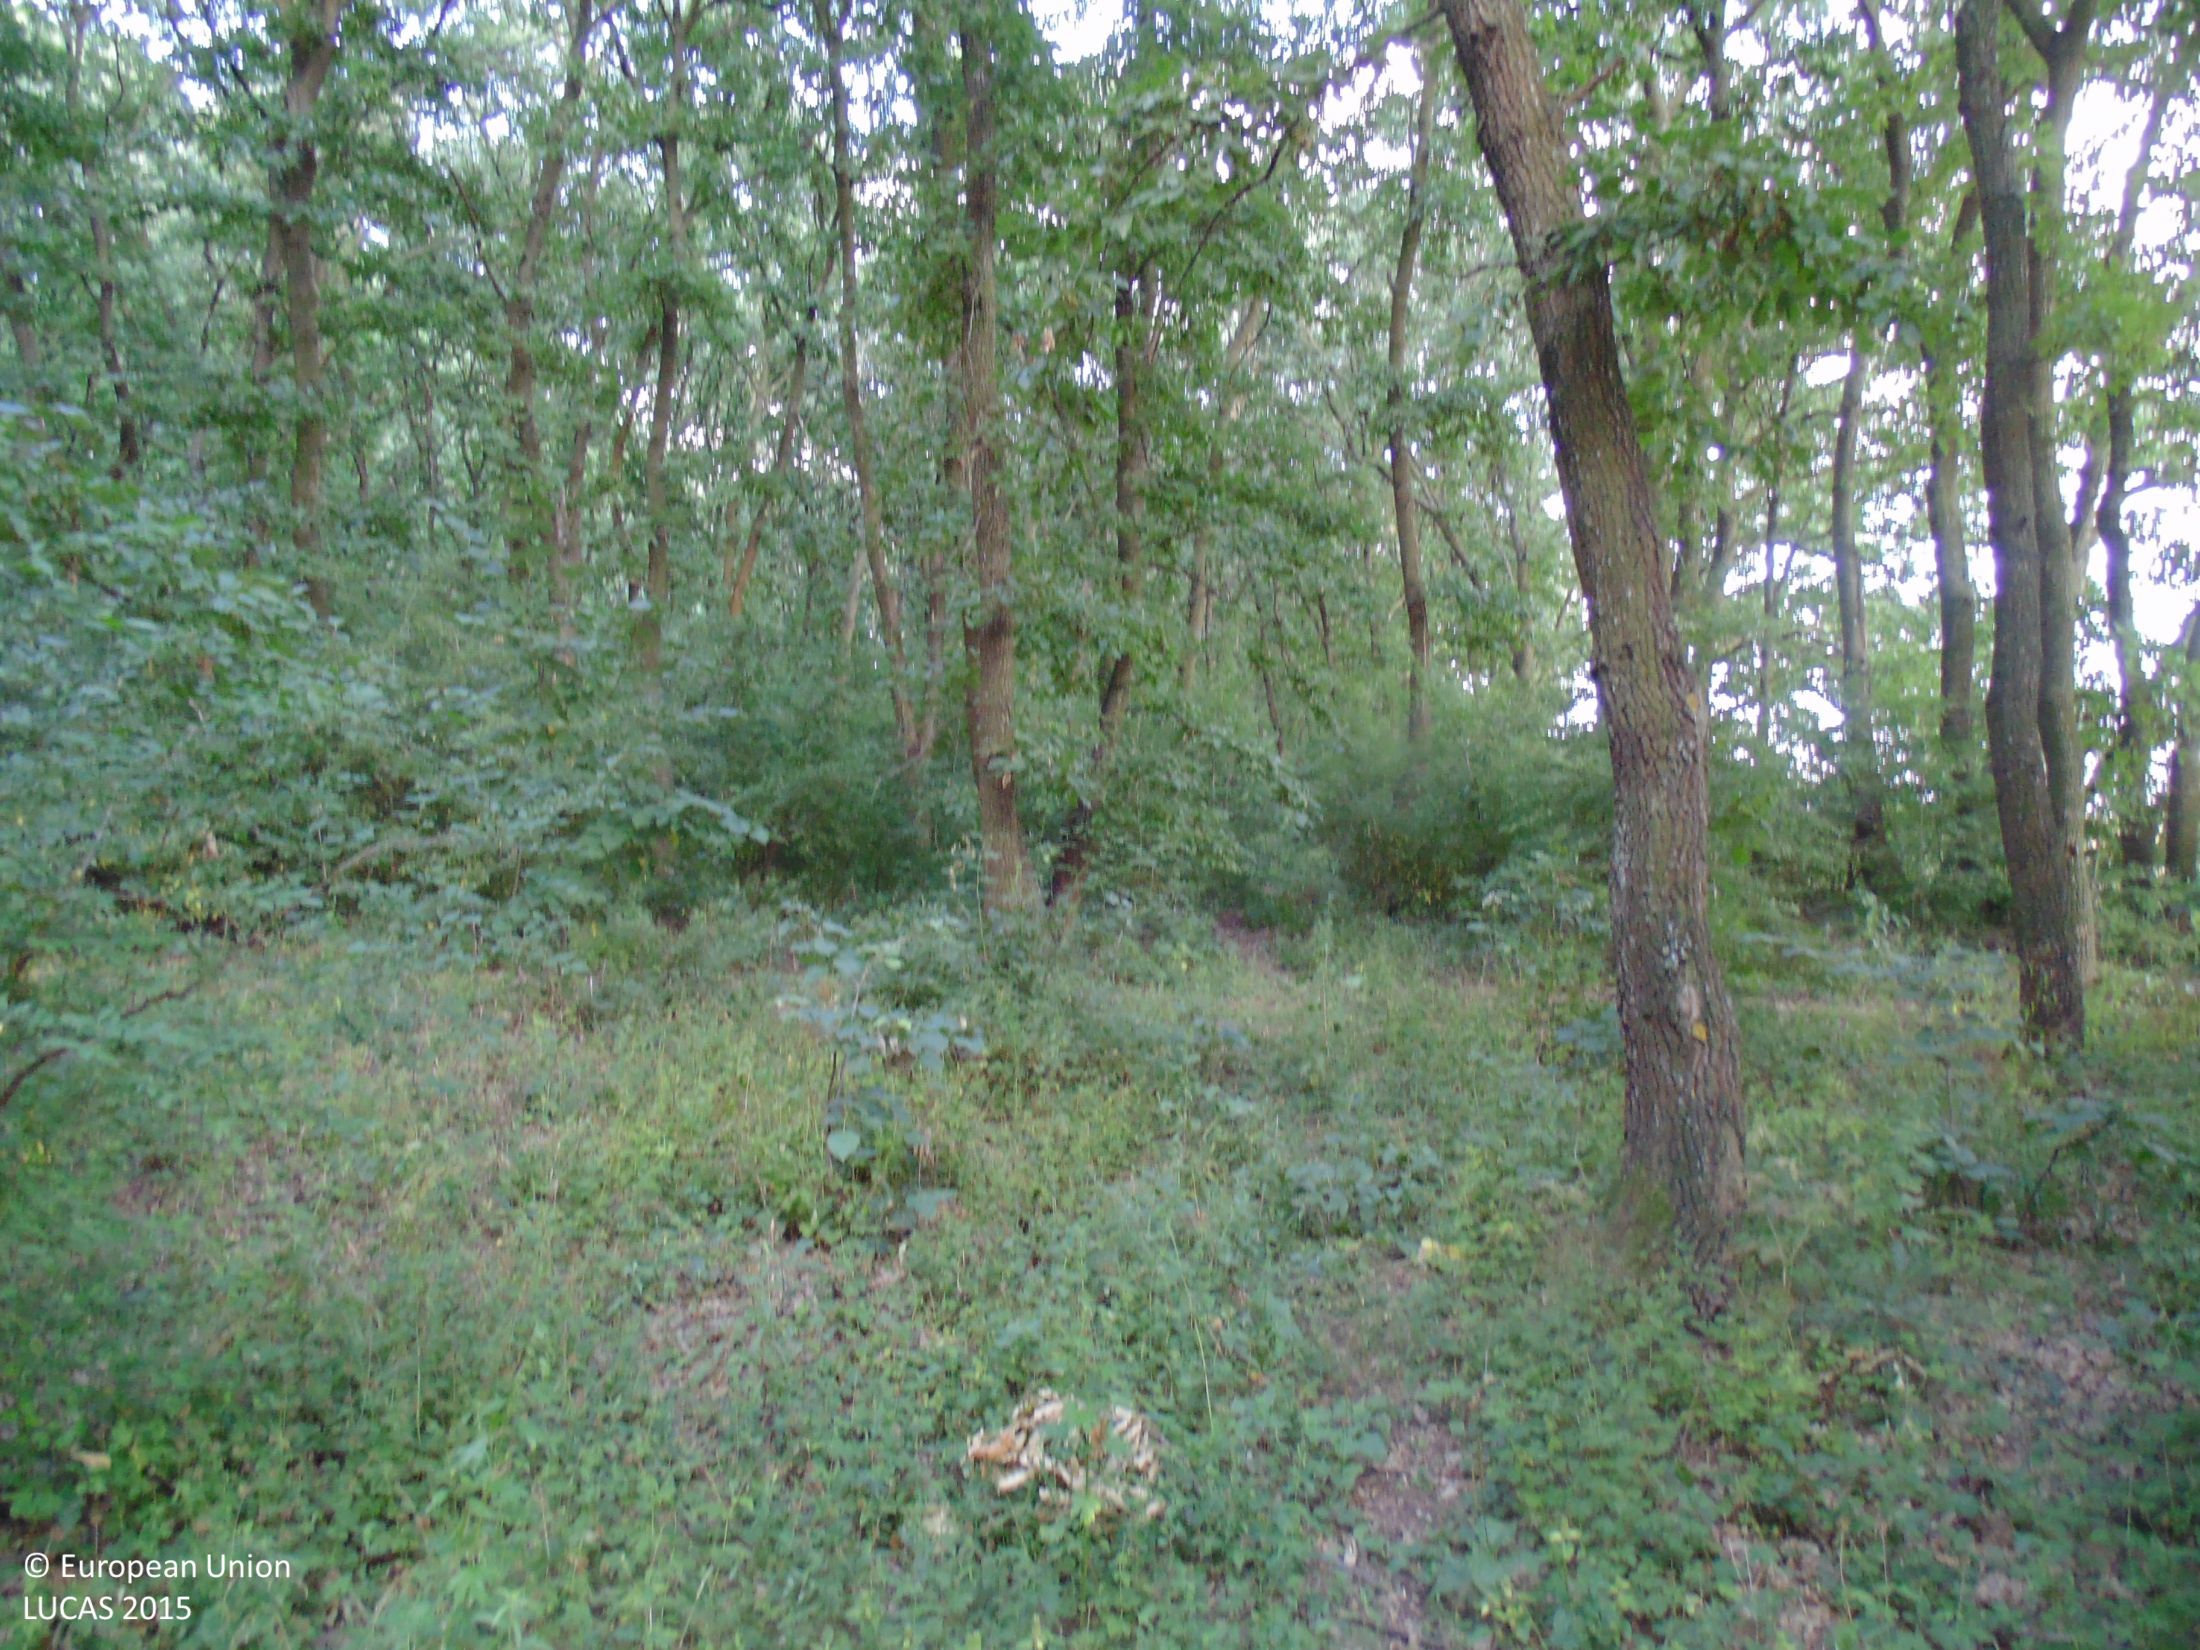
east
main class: Woodland
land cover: Broadleaved woodland
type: mesophytic deciduous forest
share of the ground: > 75 %
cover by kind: broadleaved forest trees 90 %, shrubs 5 %, herbaceous plants 5 %
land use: Forestry
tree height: > 5 m
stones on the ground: < 10 %
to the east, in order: Broadleaved woodland; Tracks; Broadleaved woodland
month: July
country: BG
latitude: 43.5203
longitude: 27.6666
